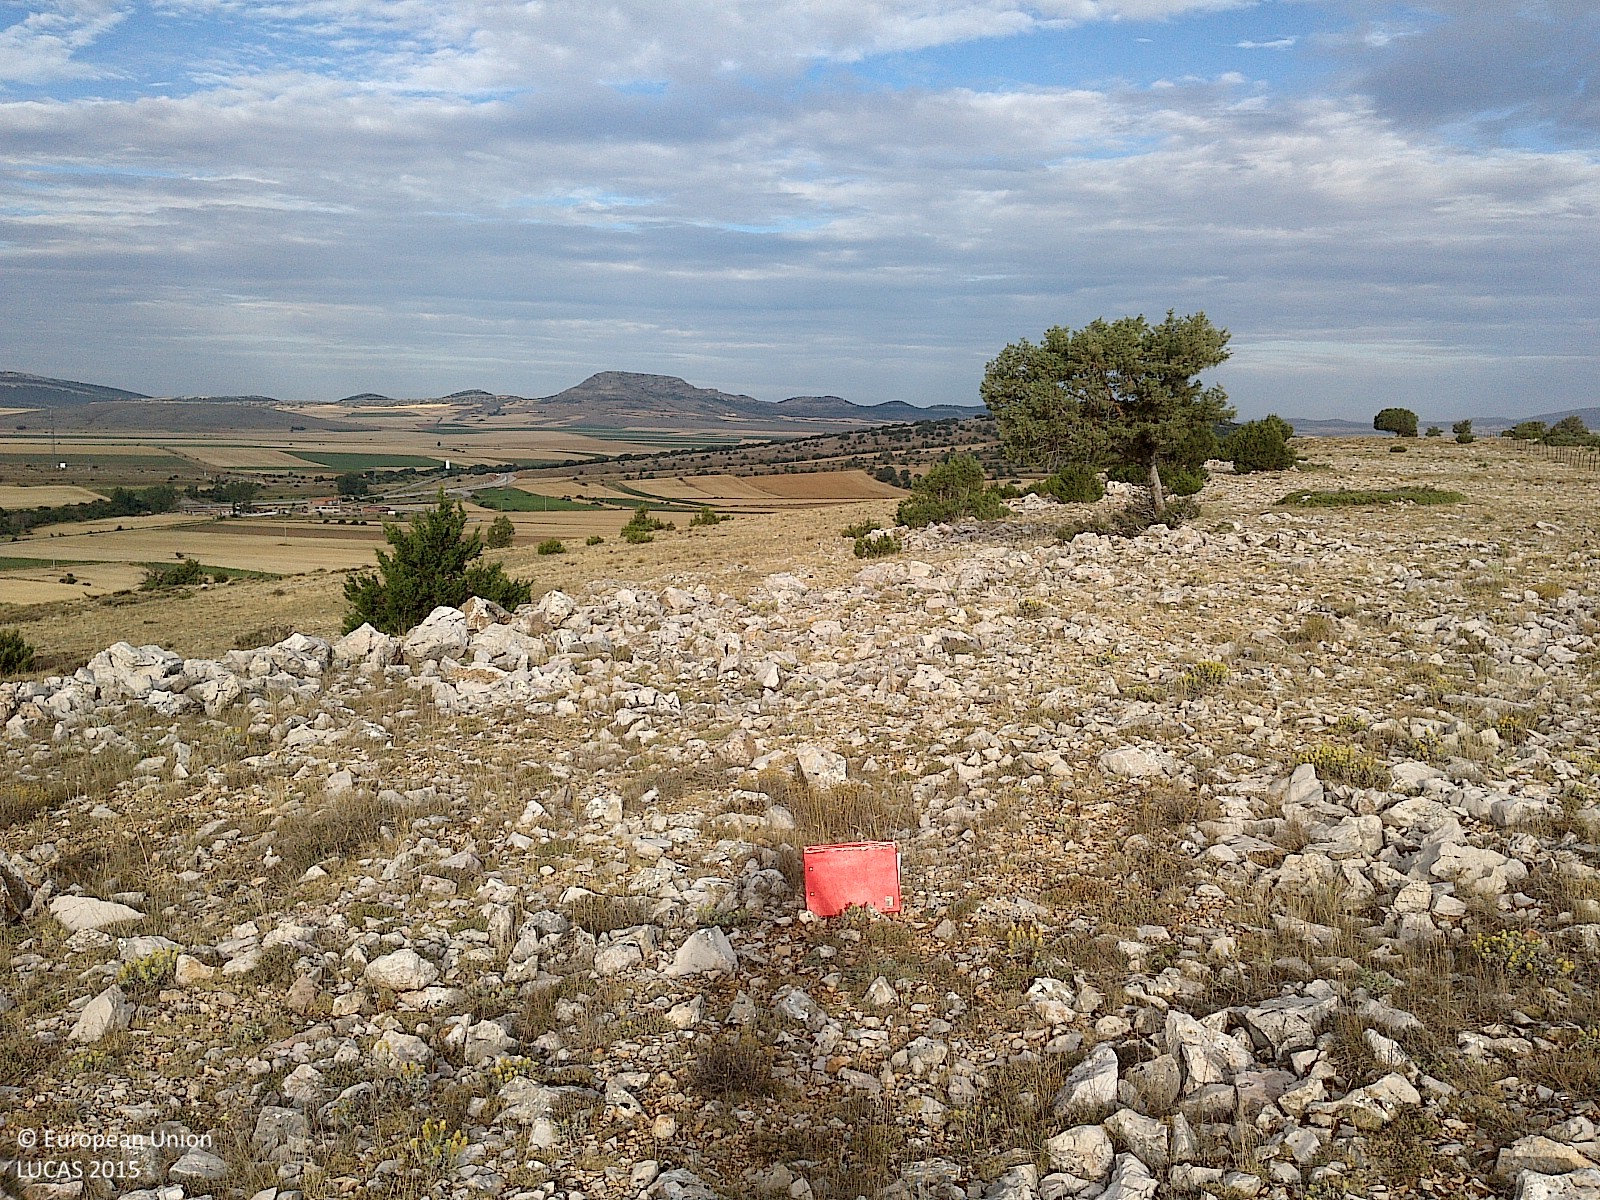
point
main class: Grassland
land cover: Grassland without tree/shrub cover
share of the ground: 25 - 50 %
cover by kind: unconsolidated bare surface 65 %, herbaceous plants 30 %, lichens and mosses 5 %
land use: Agriculture (excluding fallow land and kitchen gardens)
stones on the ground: > 50 %
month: July
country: ES
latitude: 41.6279
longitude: -1.9986
